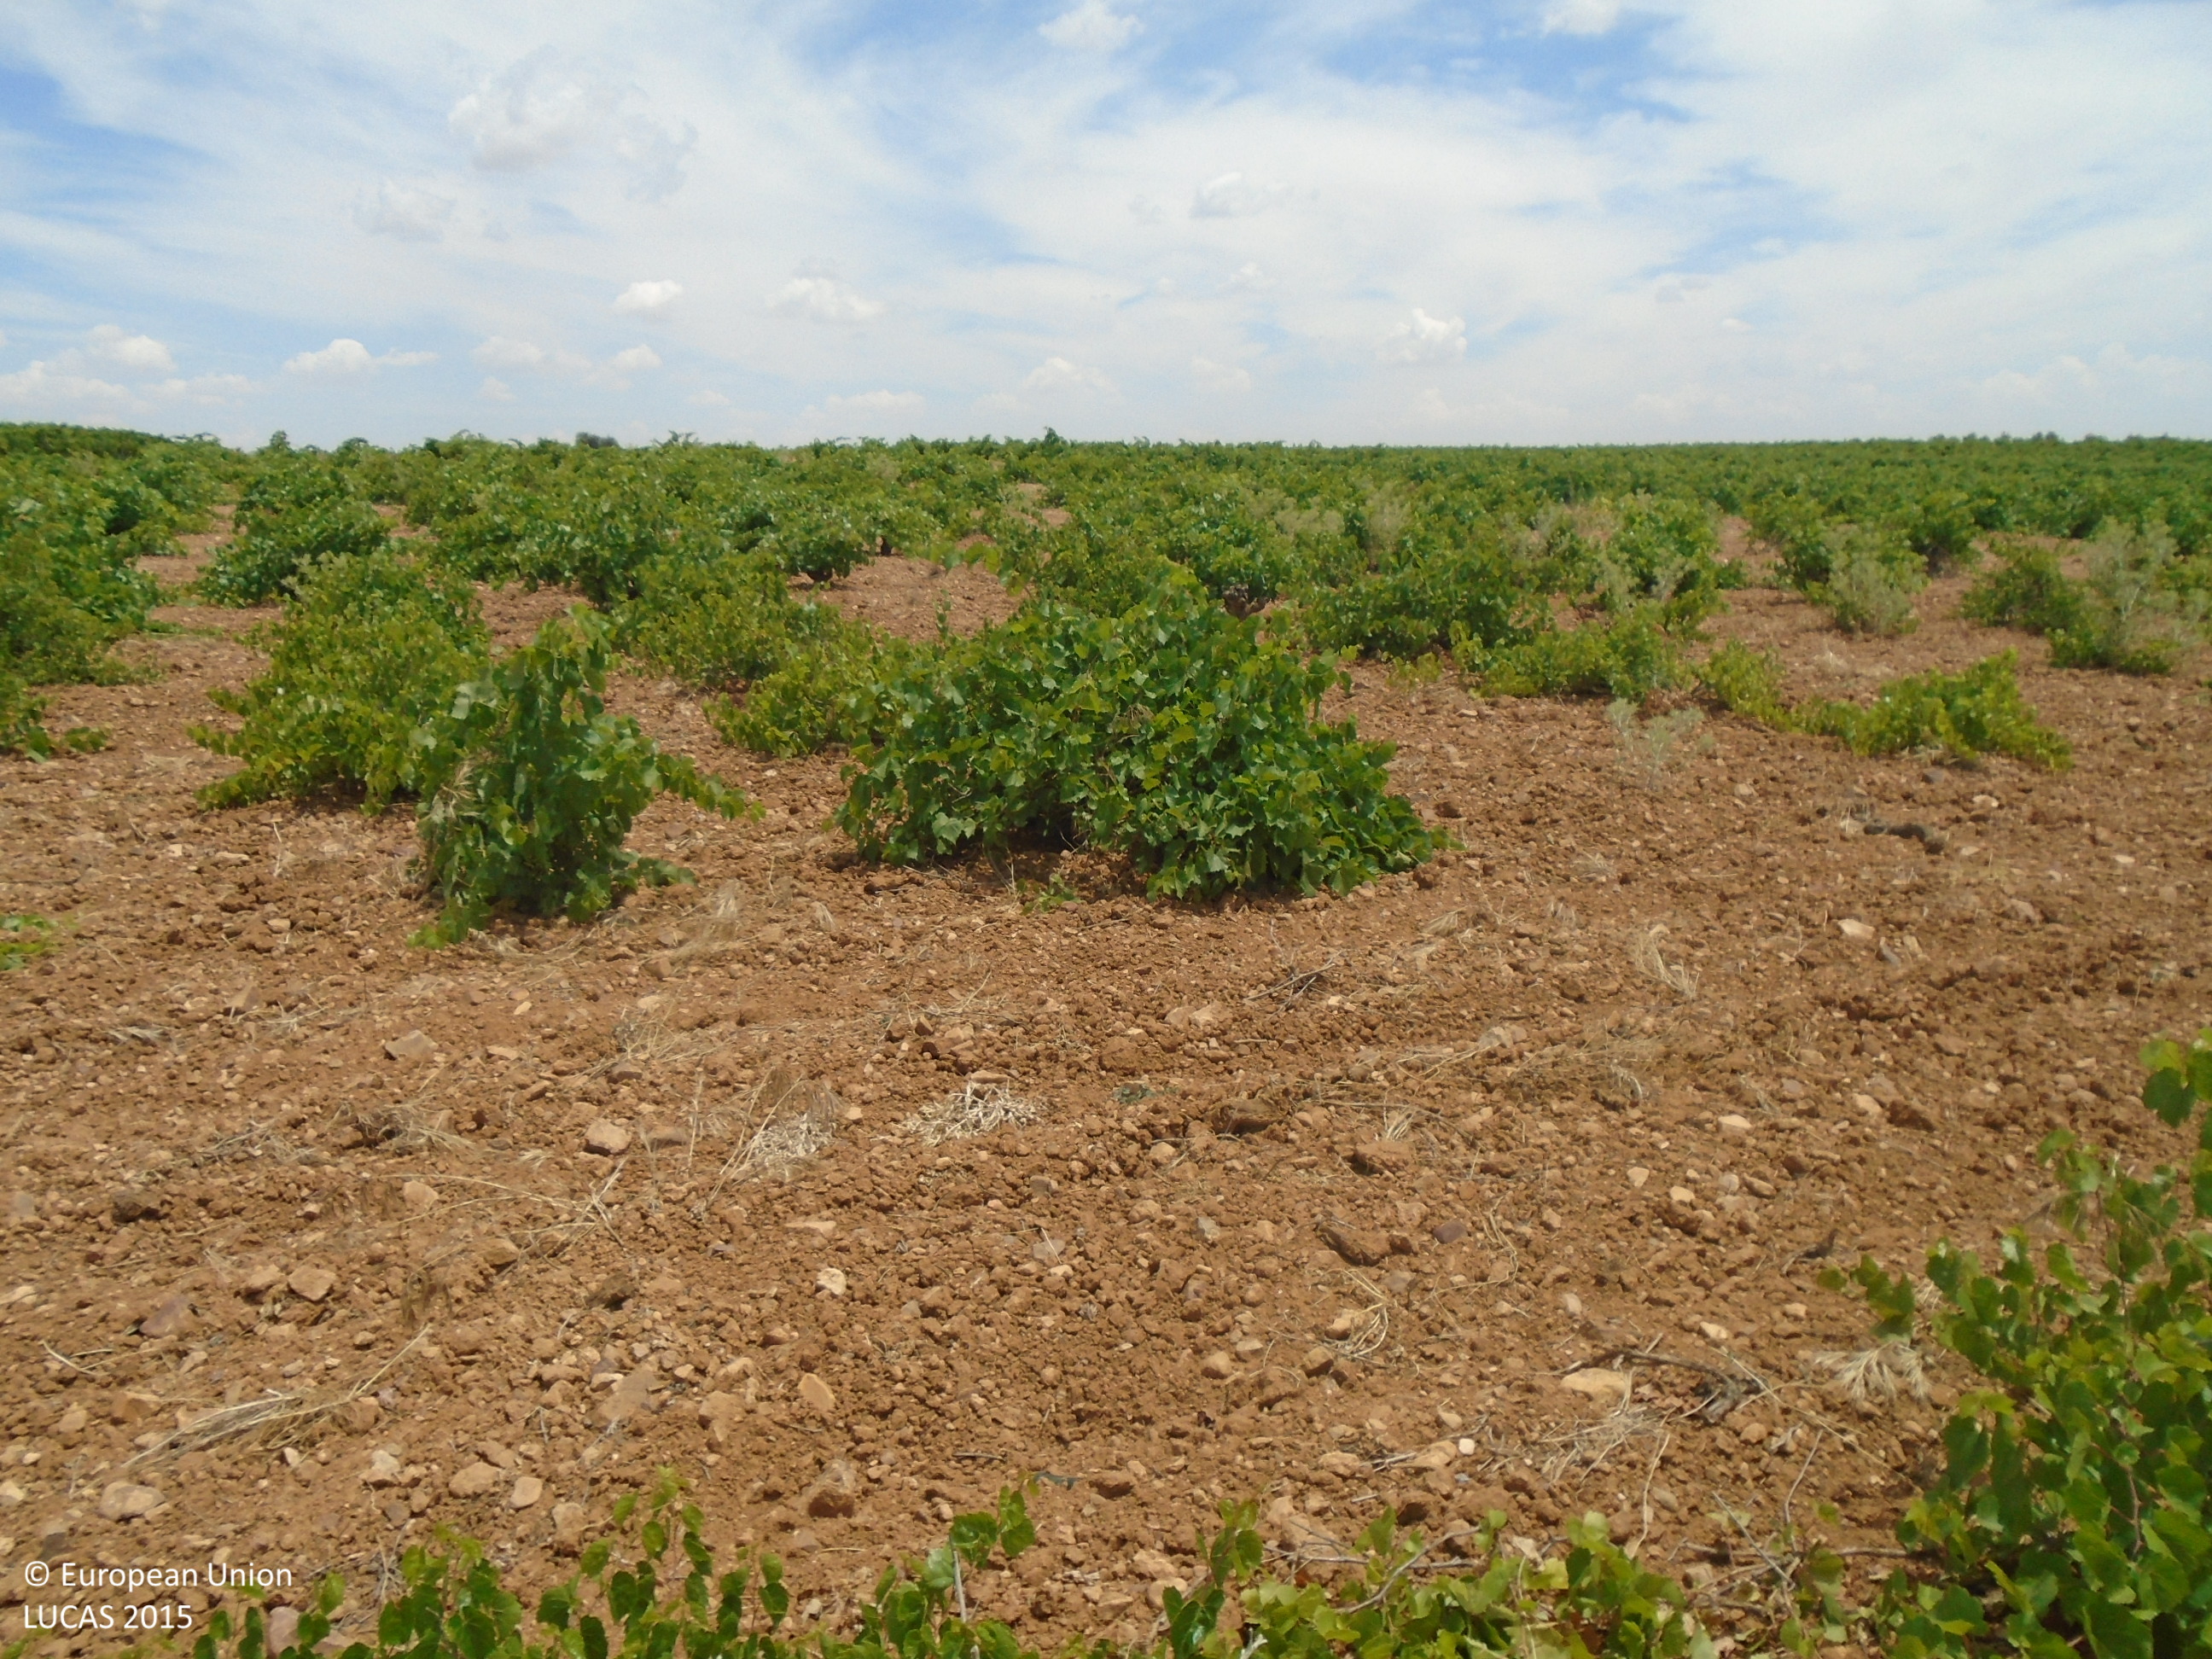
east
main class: Cropland
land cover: Vineyards
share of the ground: 25 - 50 %
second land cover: Other bare soil
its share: > 75 %
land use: Agriculture (excluding fallow land and kitchen gardens)
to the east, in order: Vineyards; Other bare soil; Tracks; Vineyards
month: June
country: ES
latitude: 39.2261
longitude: -3.5843
